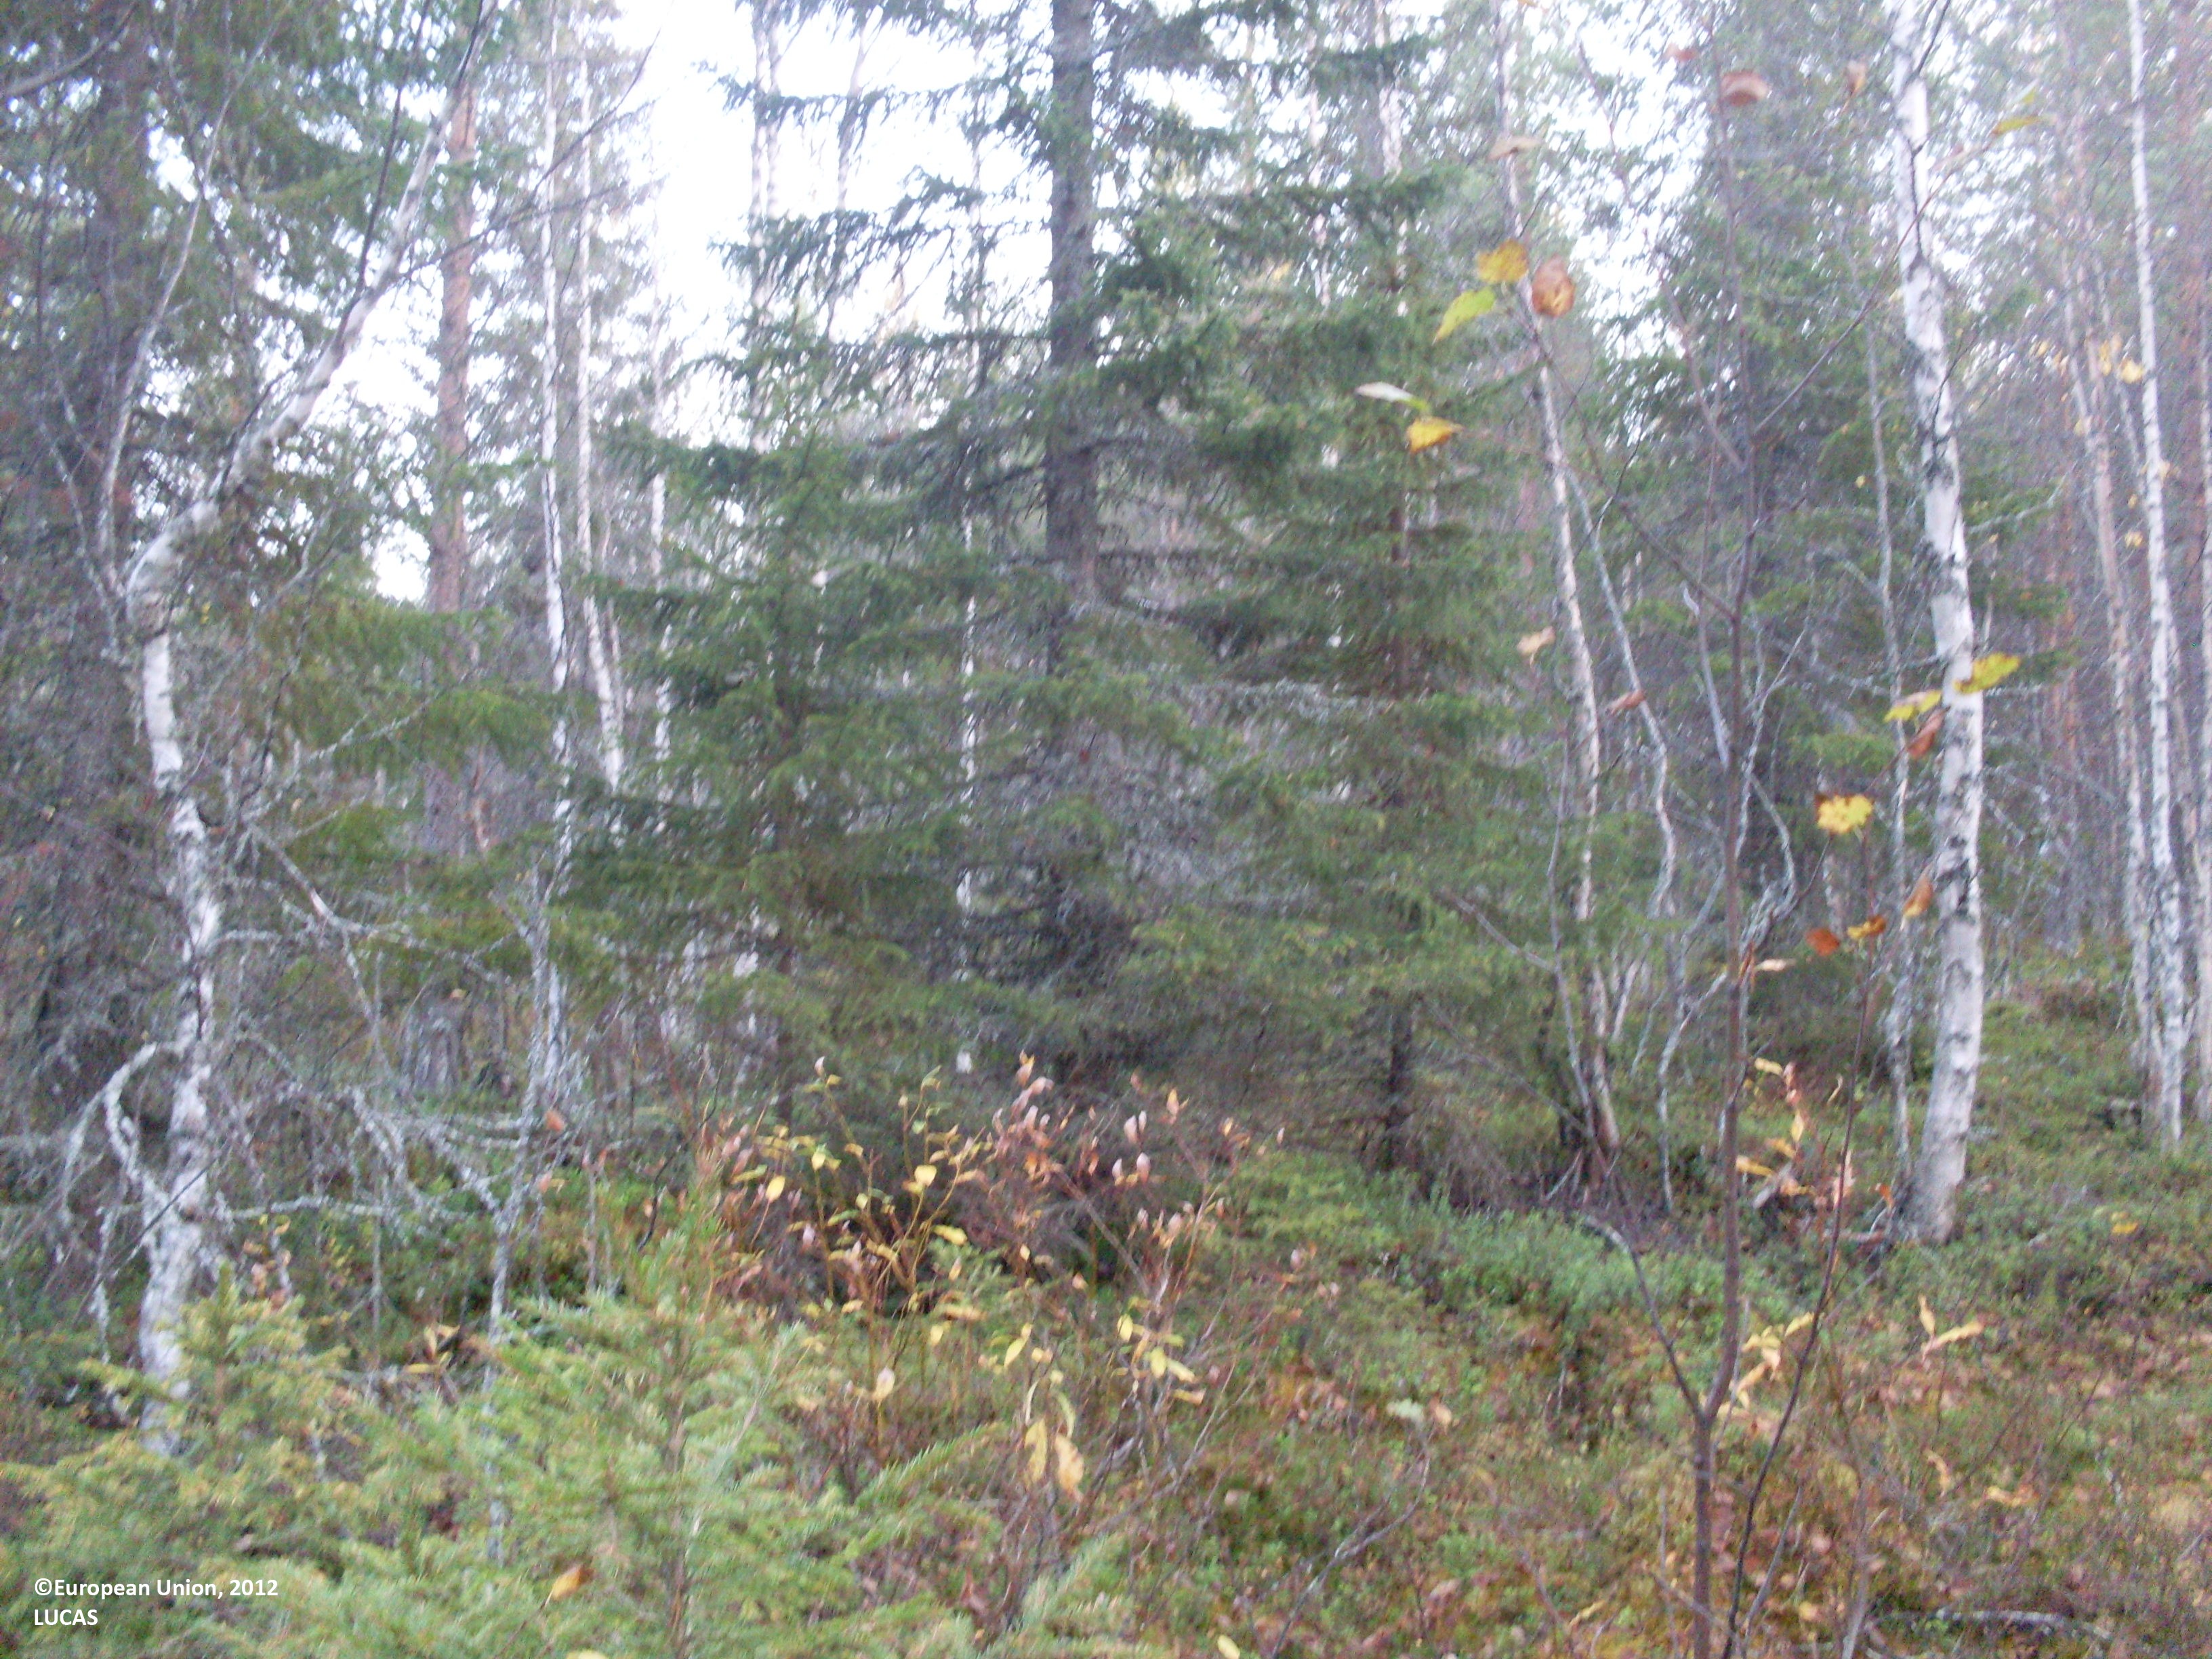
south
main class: Woodland
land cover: Pine dominated mixed woodland
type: boreal forest
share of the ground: 50 - 75 %
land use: Forestry
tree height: > 5 m
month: September
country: FI
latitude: 64.6180
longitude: 29.5979
